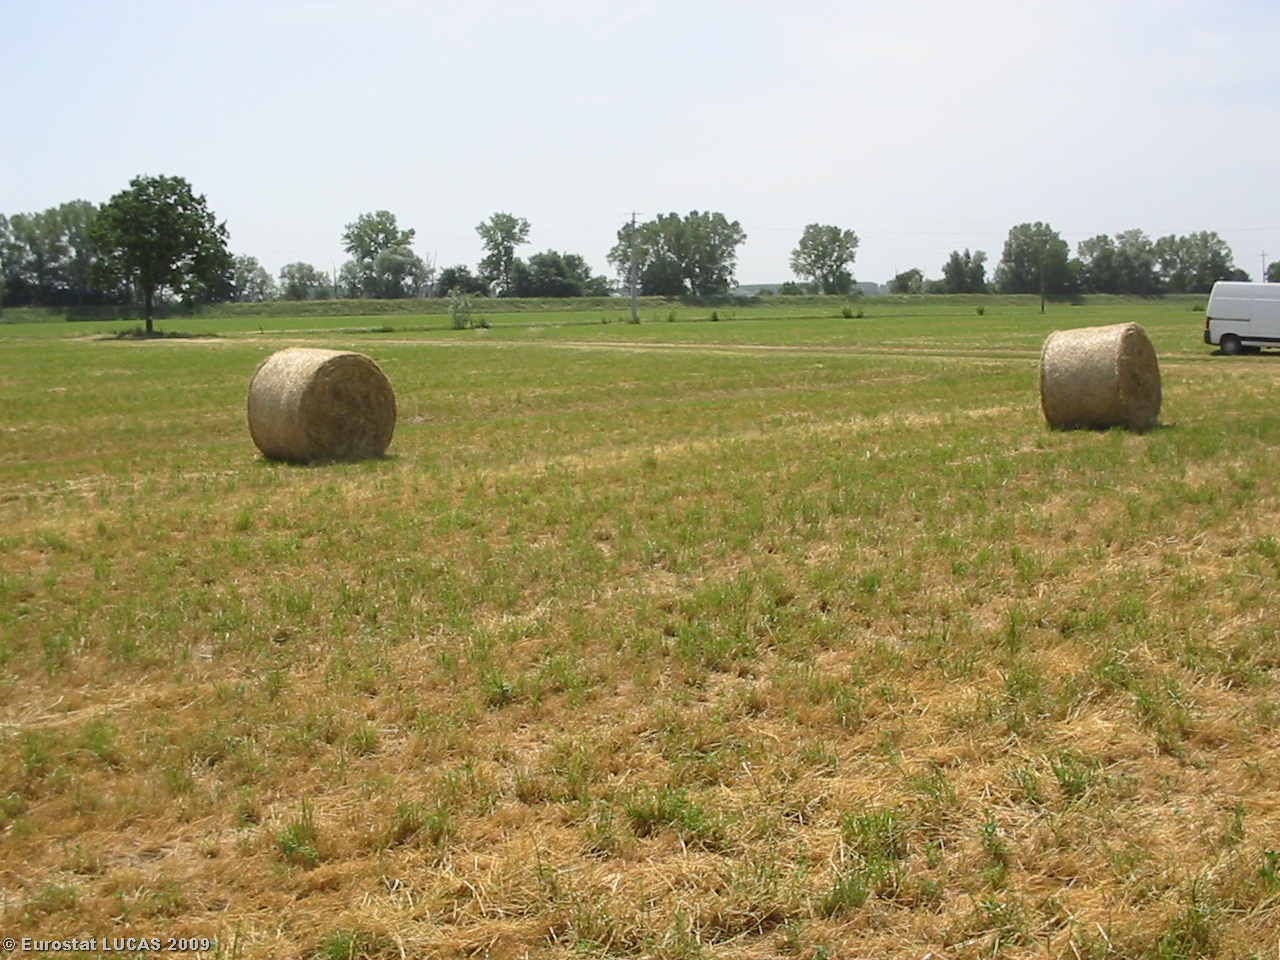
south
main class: Cropland
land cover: Lucerne
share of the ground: < 10 %
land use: Agriculture (excluding fallow land and kitchen gardens)
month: May
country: IT
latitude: 44.9451
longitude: 10.3415
